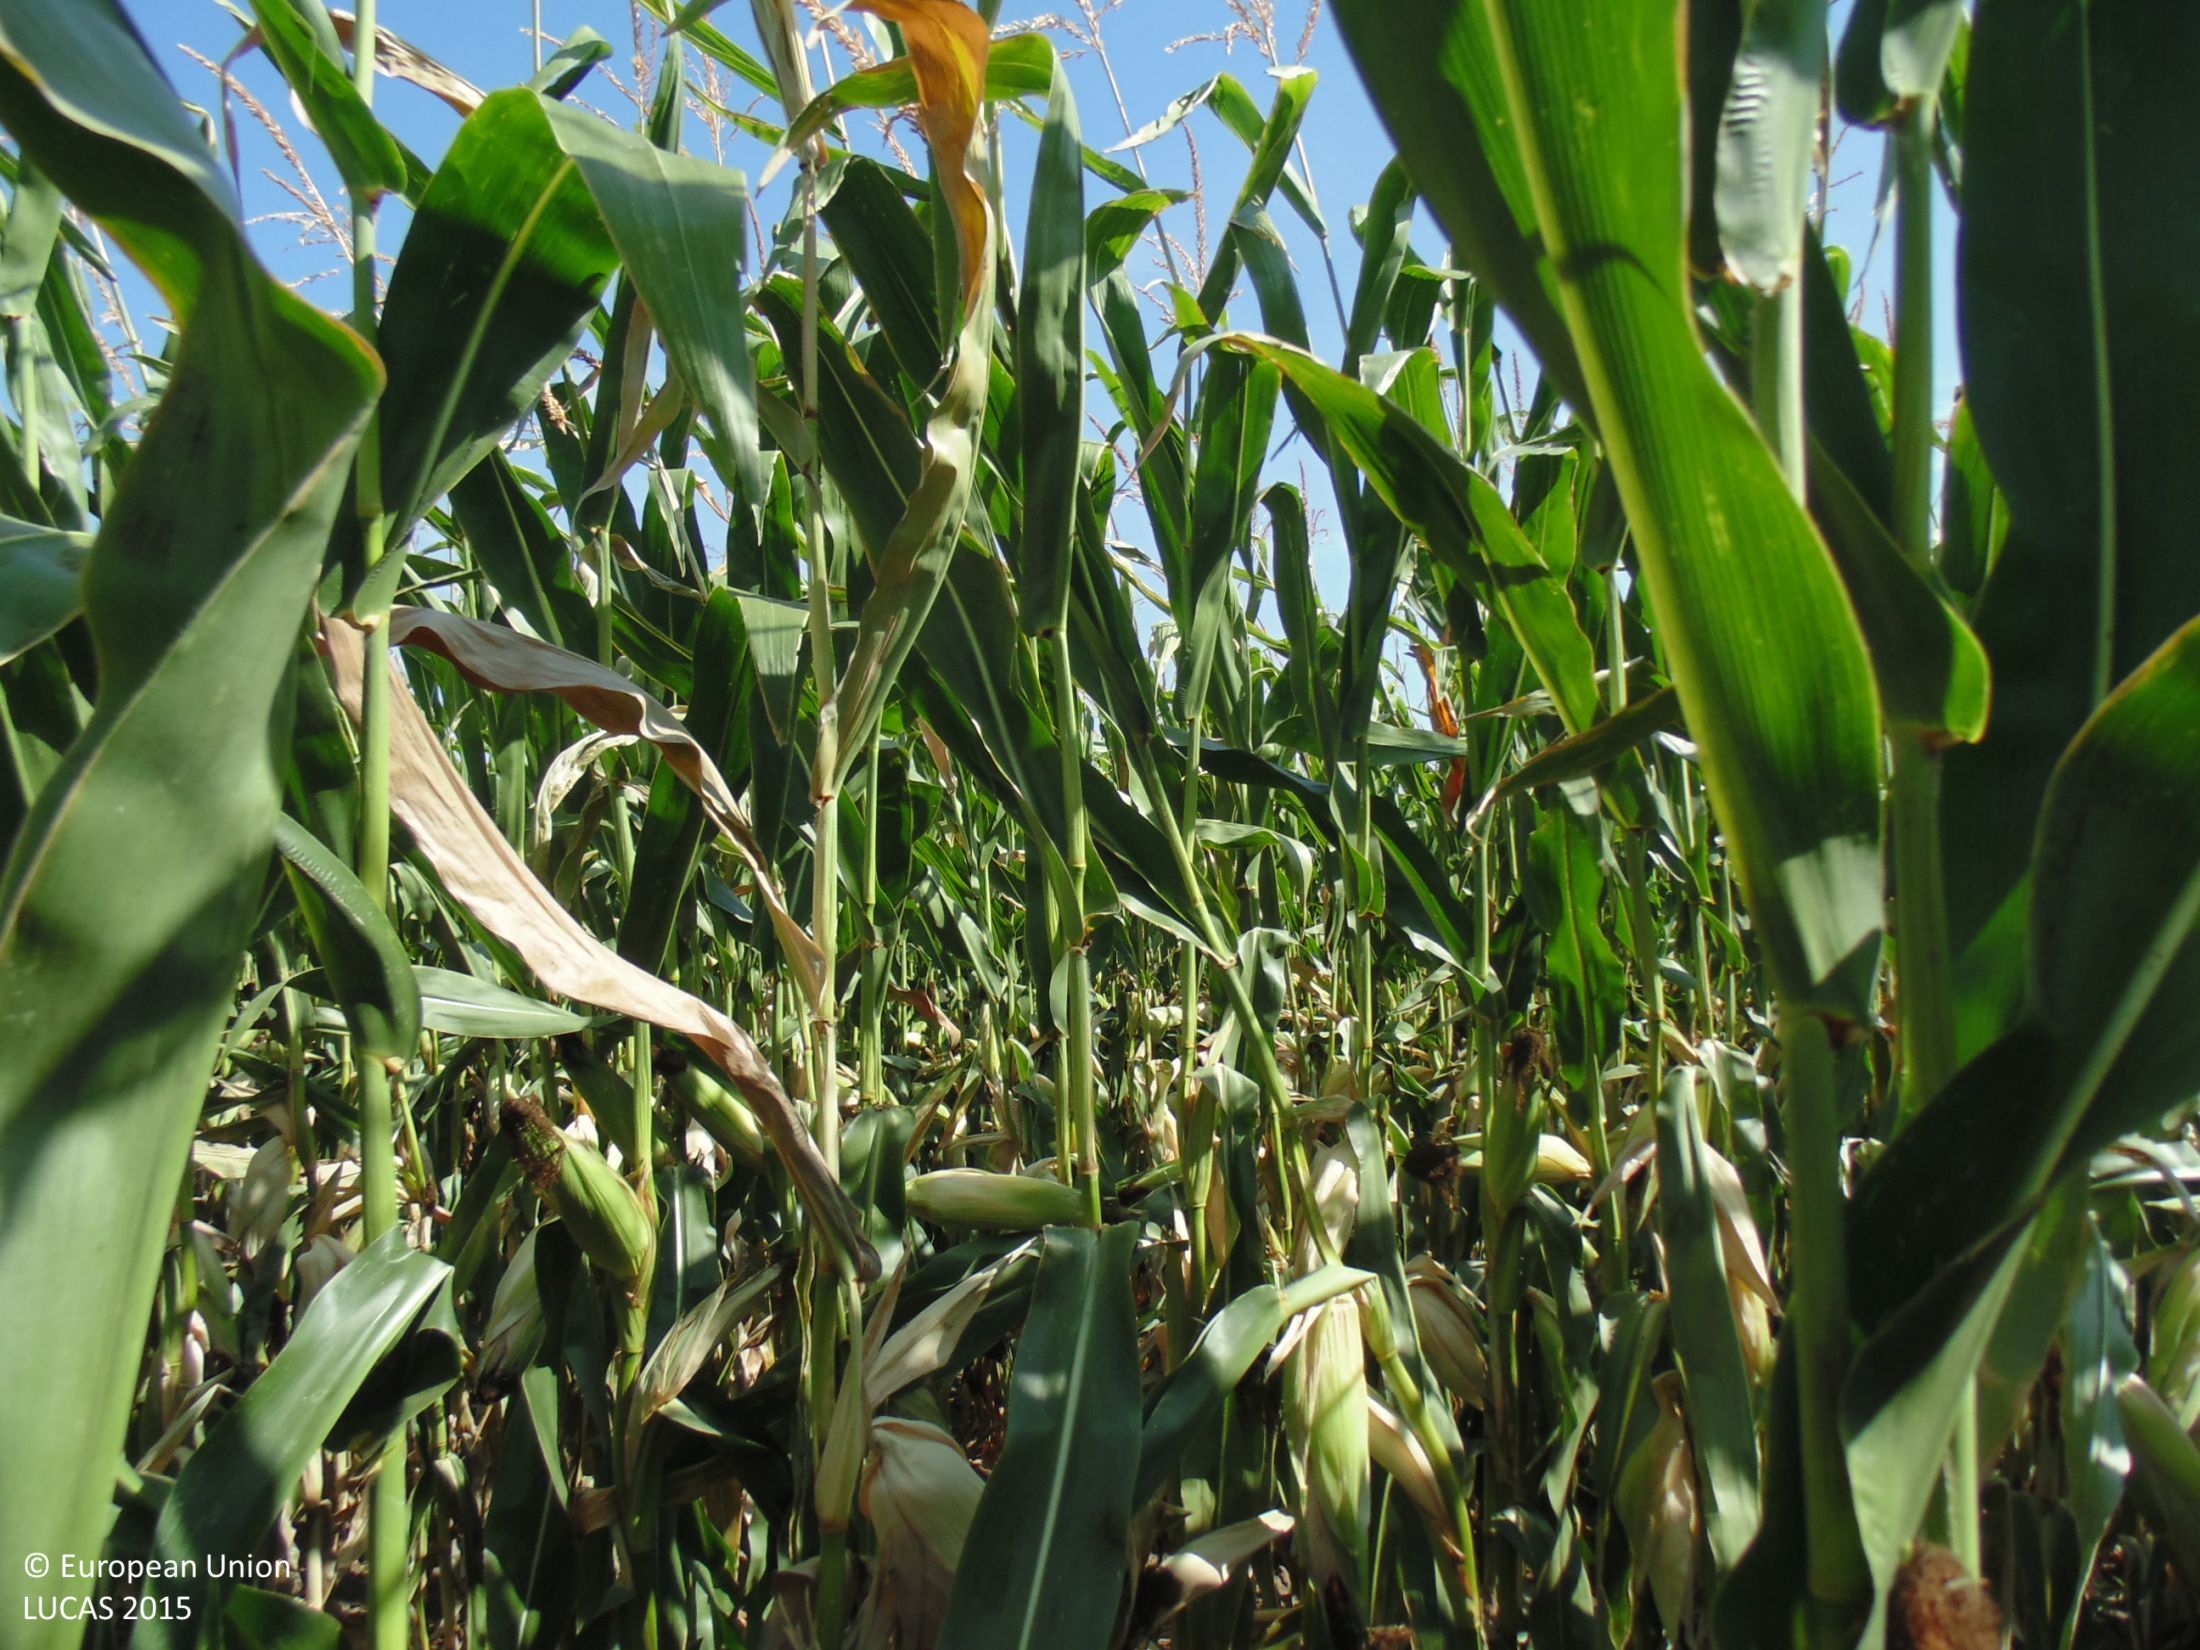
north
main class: Cropland
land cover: Maize
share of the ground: > 75 %
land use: Agriculture (excluding fallow land and kitchen gardens)
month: August
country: BG
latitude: 43.6615
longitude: 28.2221
